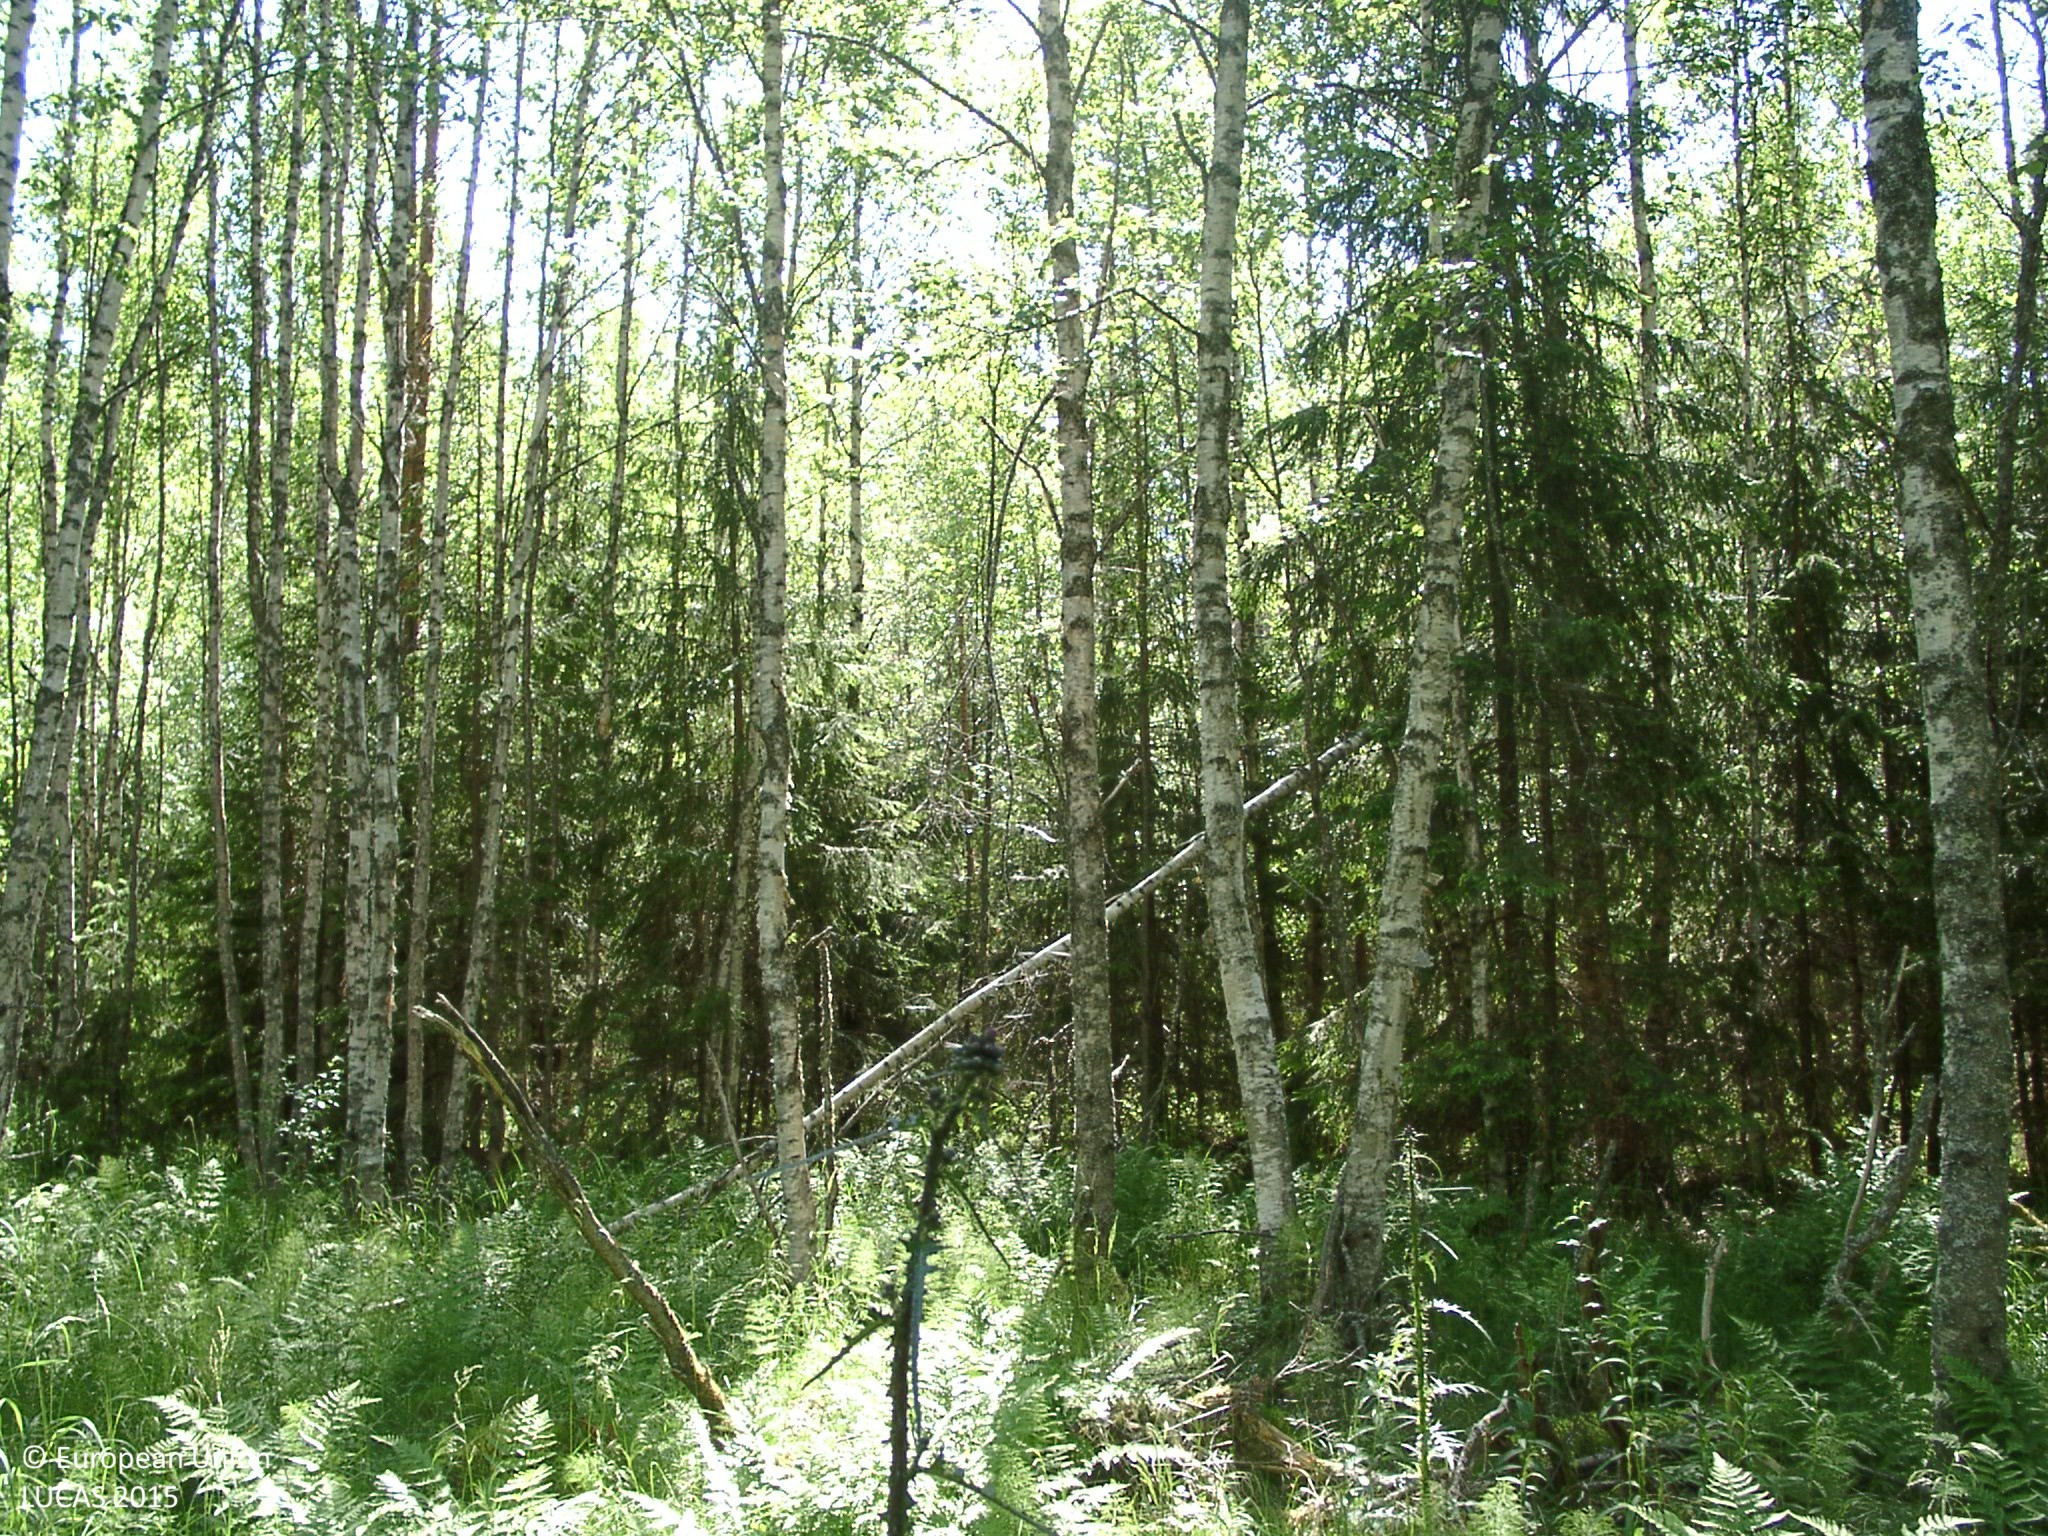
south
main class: Woodland
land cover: Spruce dominated mixed woodland
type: non-riverine alder, birch or aspen forest
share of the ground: 25 - 50 %
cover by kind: herbaceous plants 60 %, broadleaved forest trees 30 %, coniferous forest trees 10 %
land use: Forestry
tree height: > 5 m
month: July
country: FI
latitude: 62.0549
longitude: 25.2012
